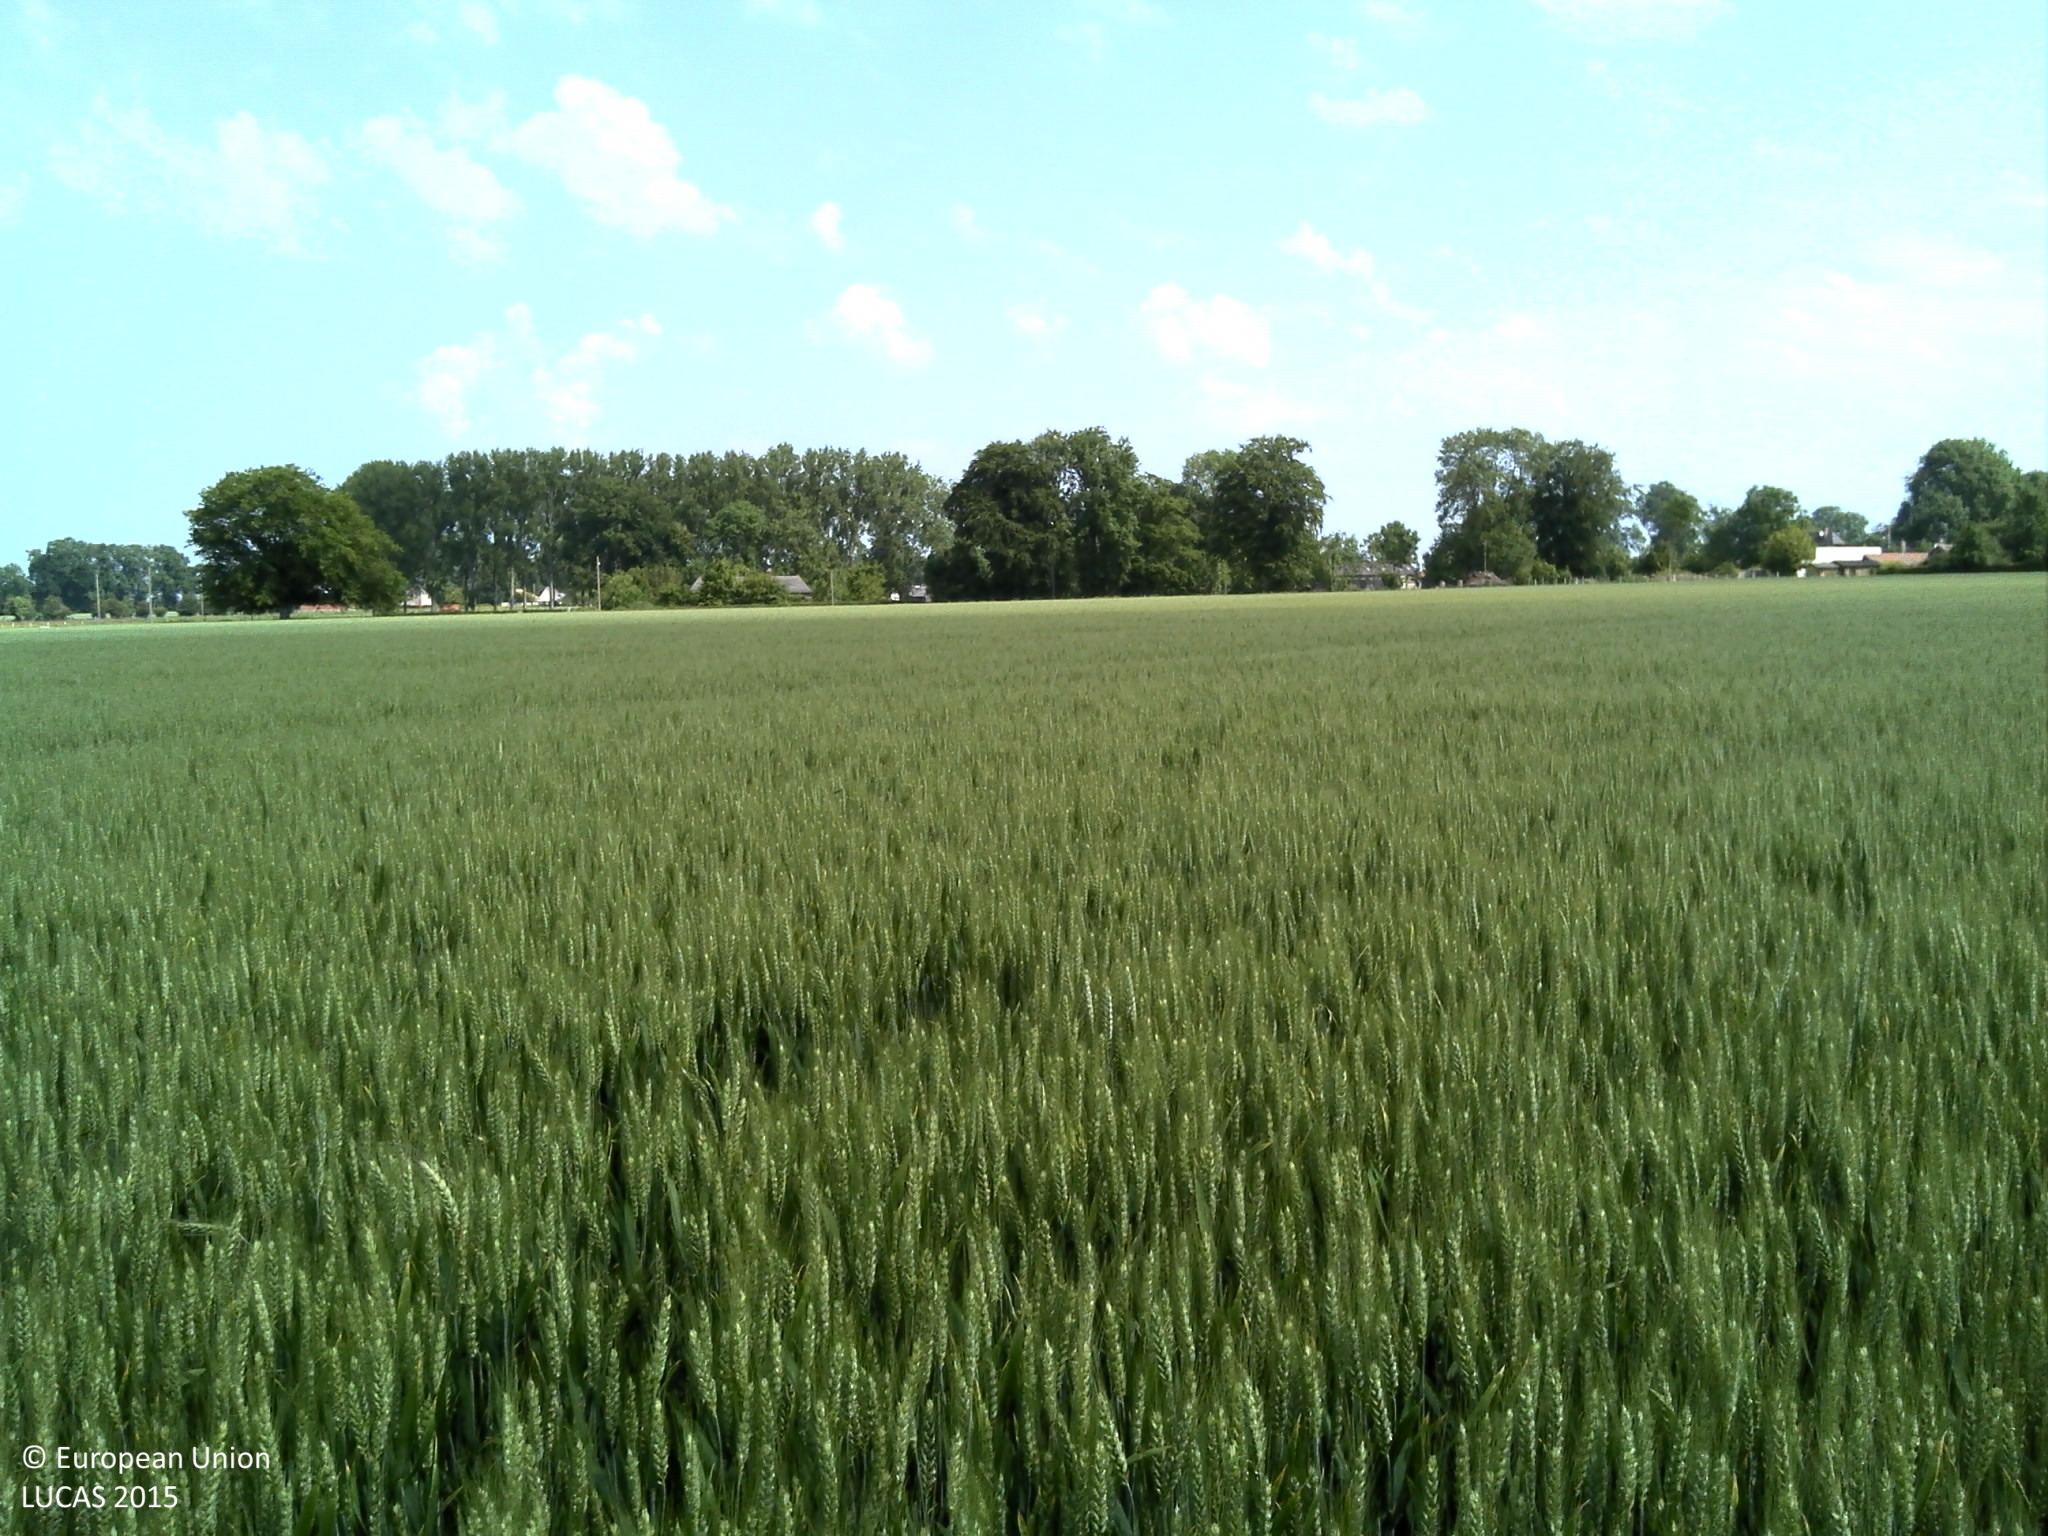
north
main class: Cropland
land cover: Common wheat
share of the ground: > 75 %
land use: Agriculture (excluding fallow land and kitchen gardens)
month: June
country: FR
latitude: 49.7595
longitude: 1.0519
